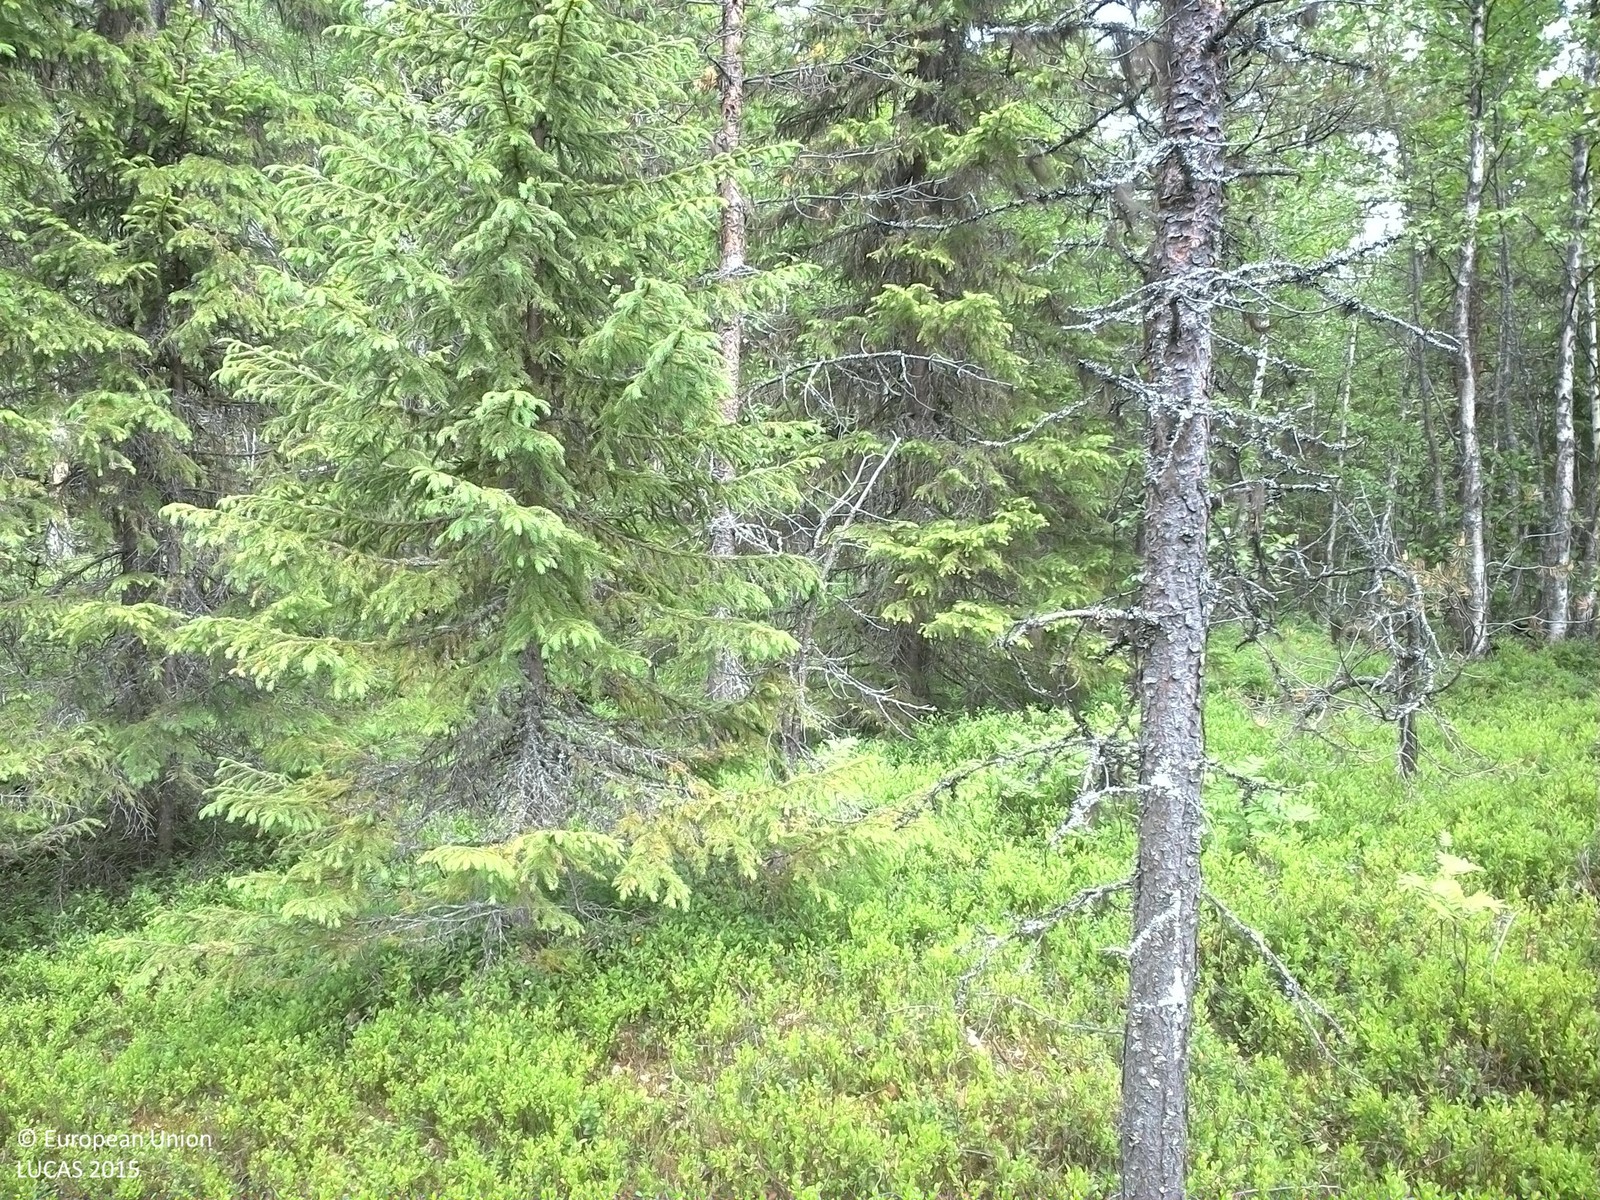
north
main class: Woodland
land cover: Spruce dominated mixed woodland
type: boreal forest
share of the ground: 50 - 75 %
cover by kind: coniferous forest trees 45 %, shrubs 30 %, broadleaved forest trees 15 %, lichens and mosses 10 %
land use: Forestry
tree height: > 5 m
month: July
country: SE
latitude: 64.1251
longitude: 16.8089
